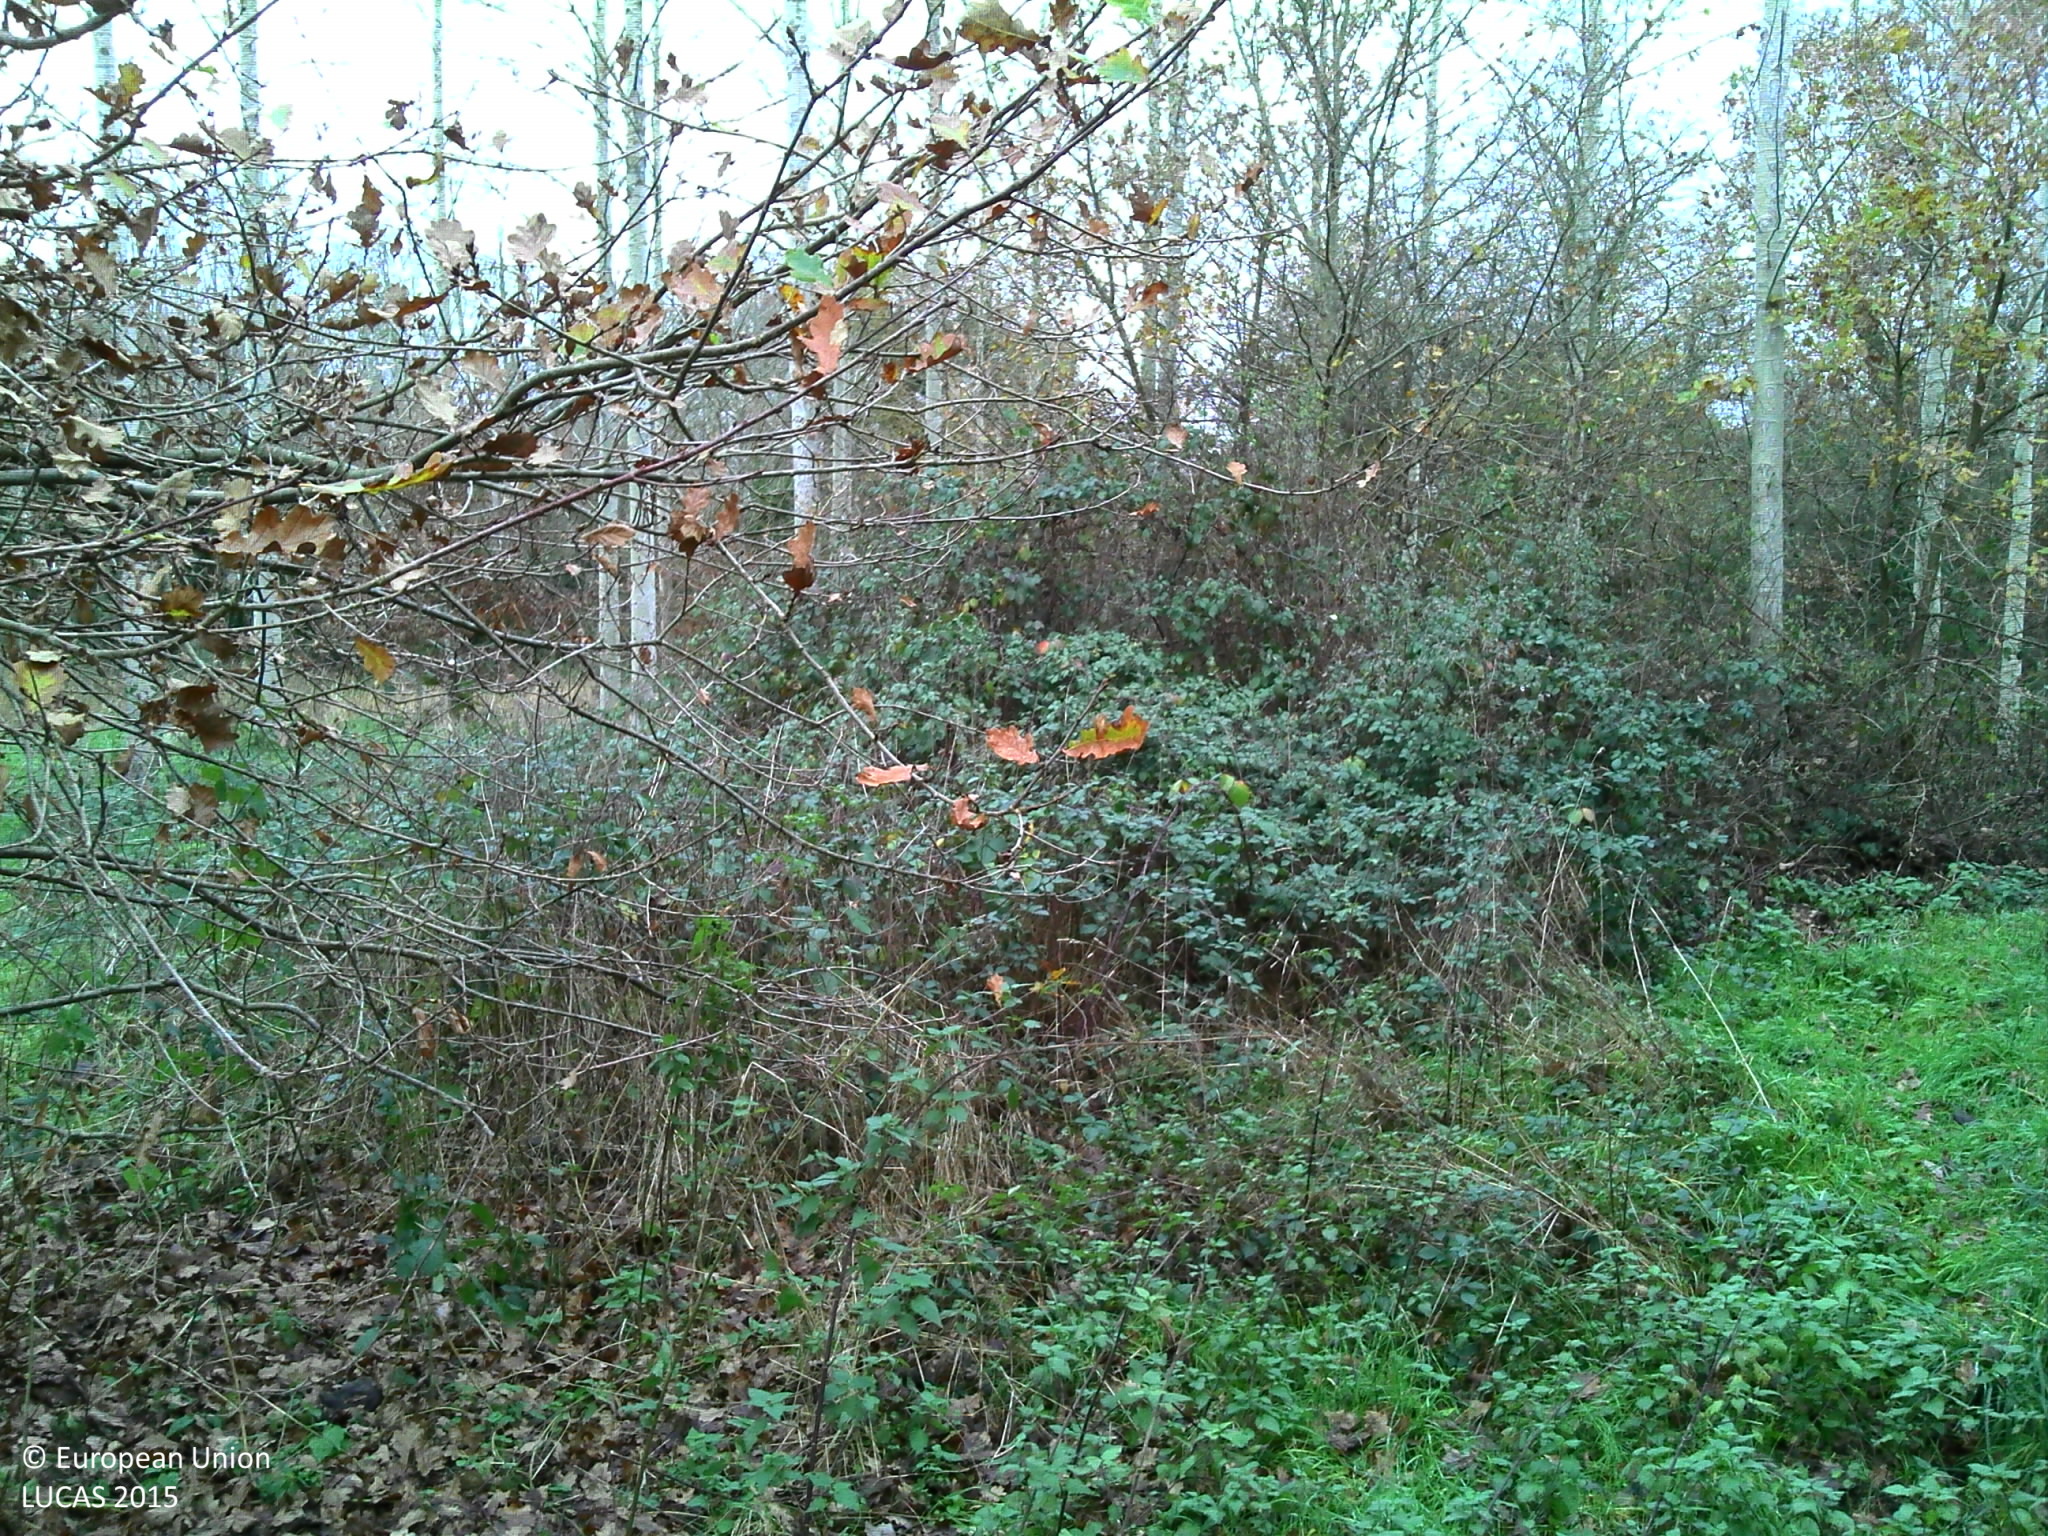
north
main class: Woodland
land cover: Broadleaved woodland
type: acidophilous oak and oak-birch forest
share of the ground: > 75 %
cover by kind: broadleaved forest trees 60 %, herbaceous plants 30 %, shrubs 10 %
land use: Forestry
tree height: > 5 m
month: November
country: FR
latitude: 46.6825
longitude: 3.2907
